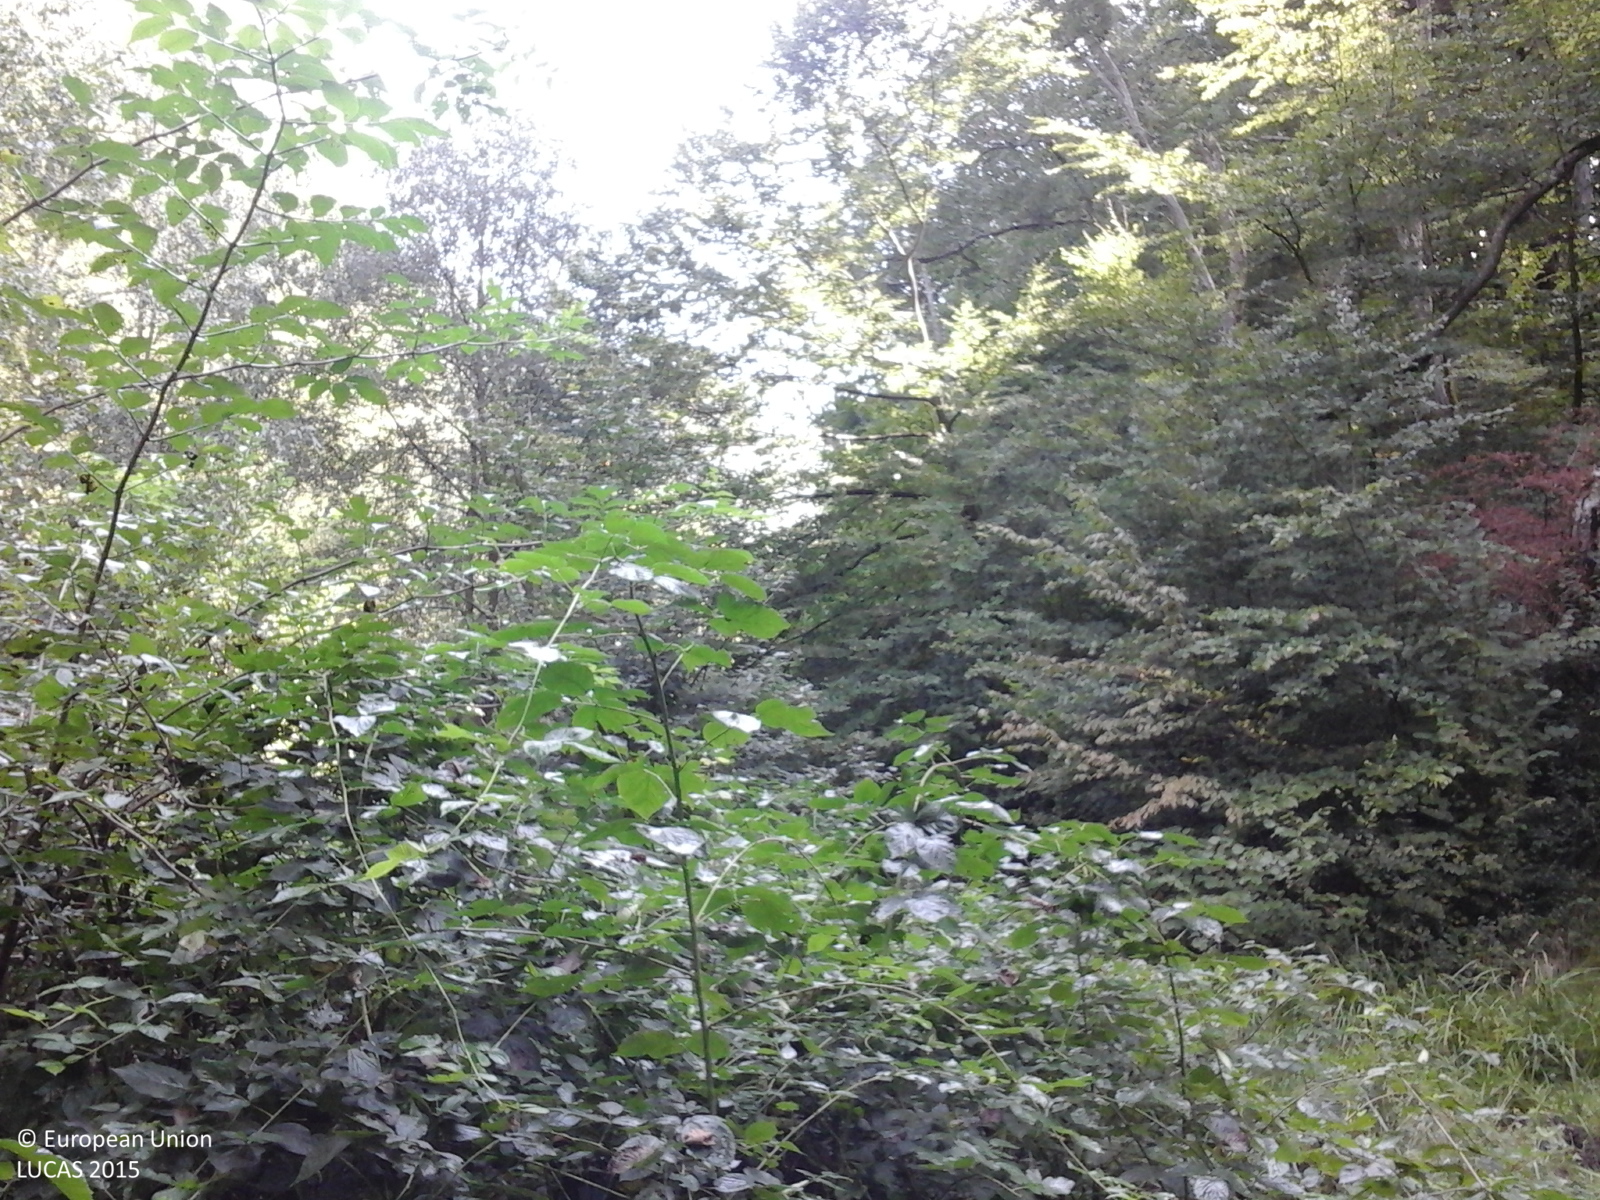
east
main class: Woodland
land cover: Broadleaved woodland
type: beech forest
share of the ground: > 75 %
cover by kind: broadleaved forest trees 100 %
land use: Forestry
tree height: > 5 m
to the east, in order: Broadleaved woodland; Rivers and streams; Spontaneously vegetated surfaces; Broadleaved woodland; Tracks; Broadleaved woodland
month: September
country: RO
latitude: 45.5906
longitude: 22.7005
